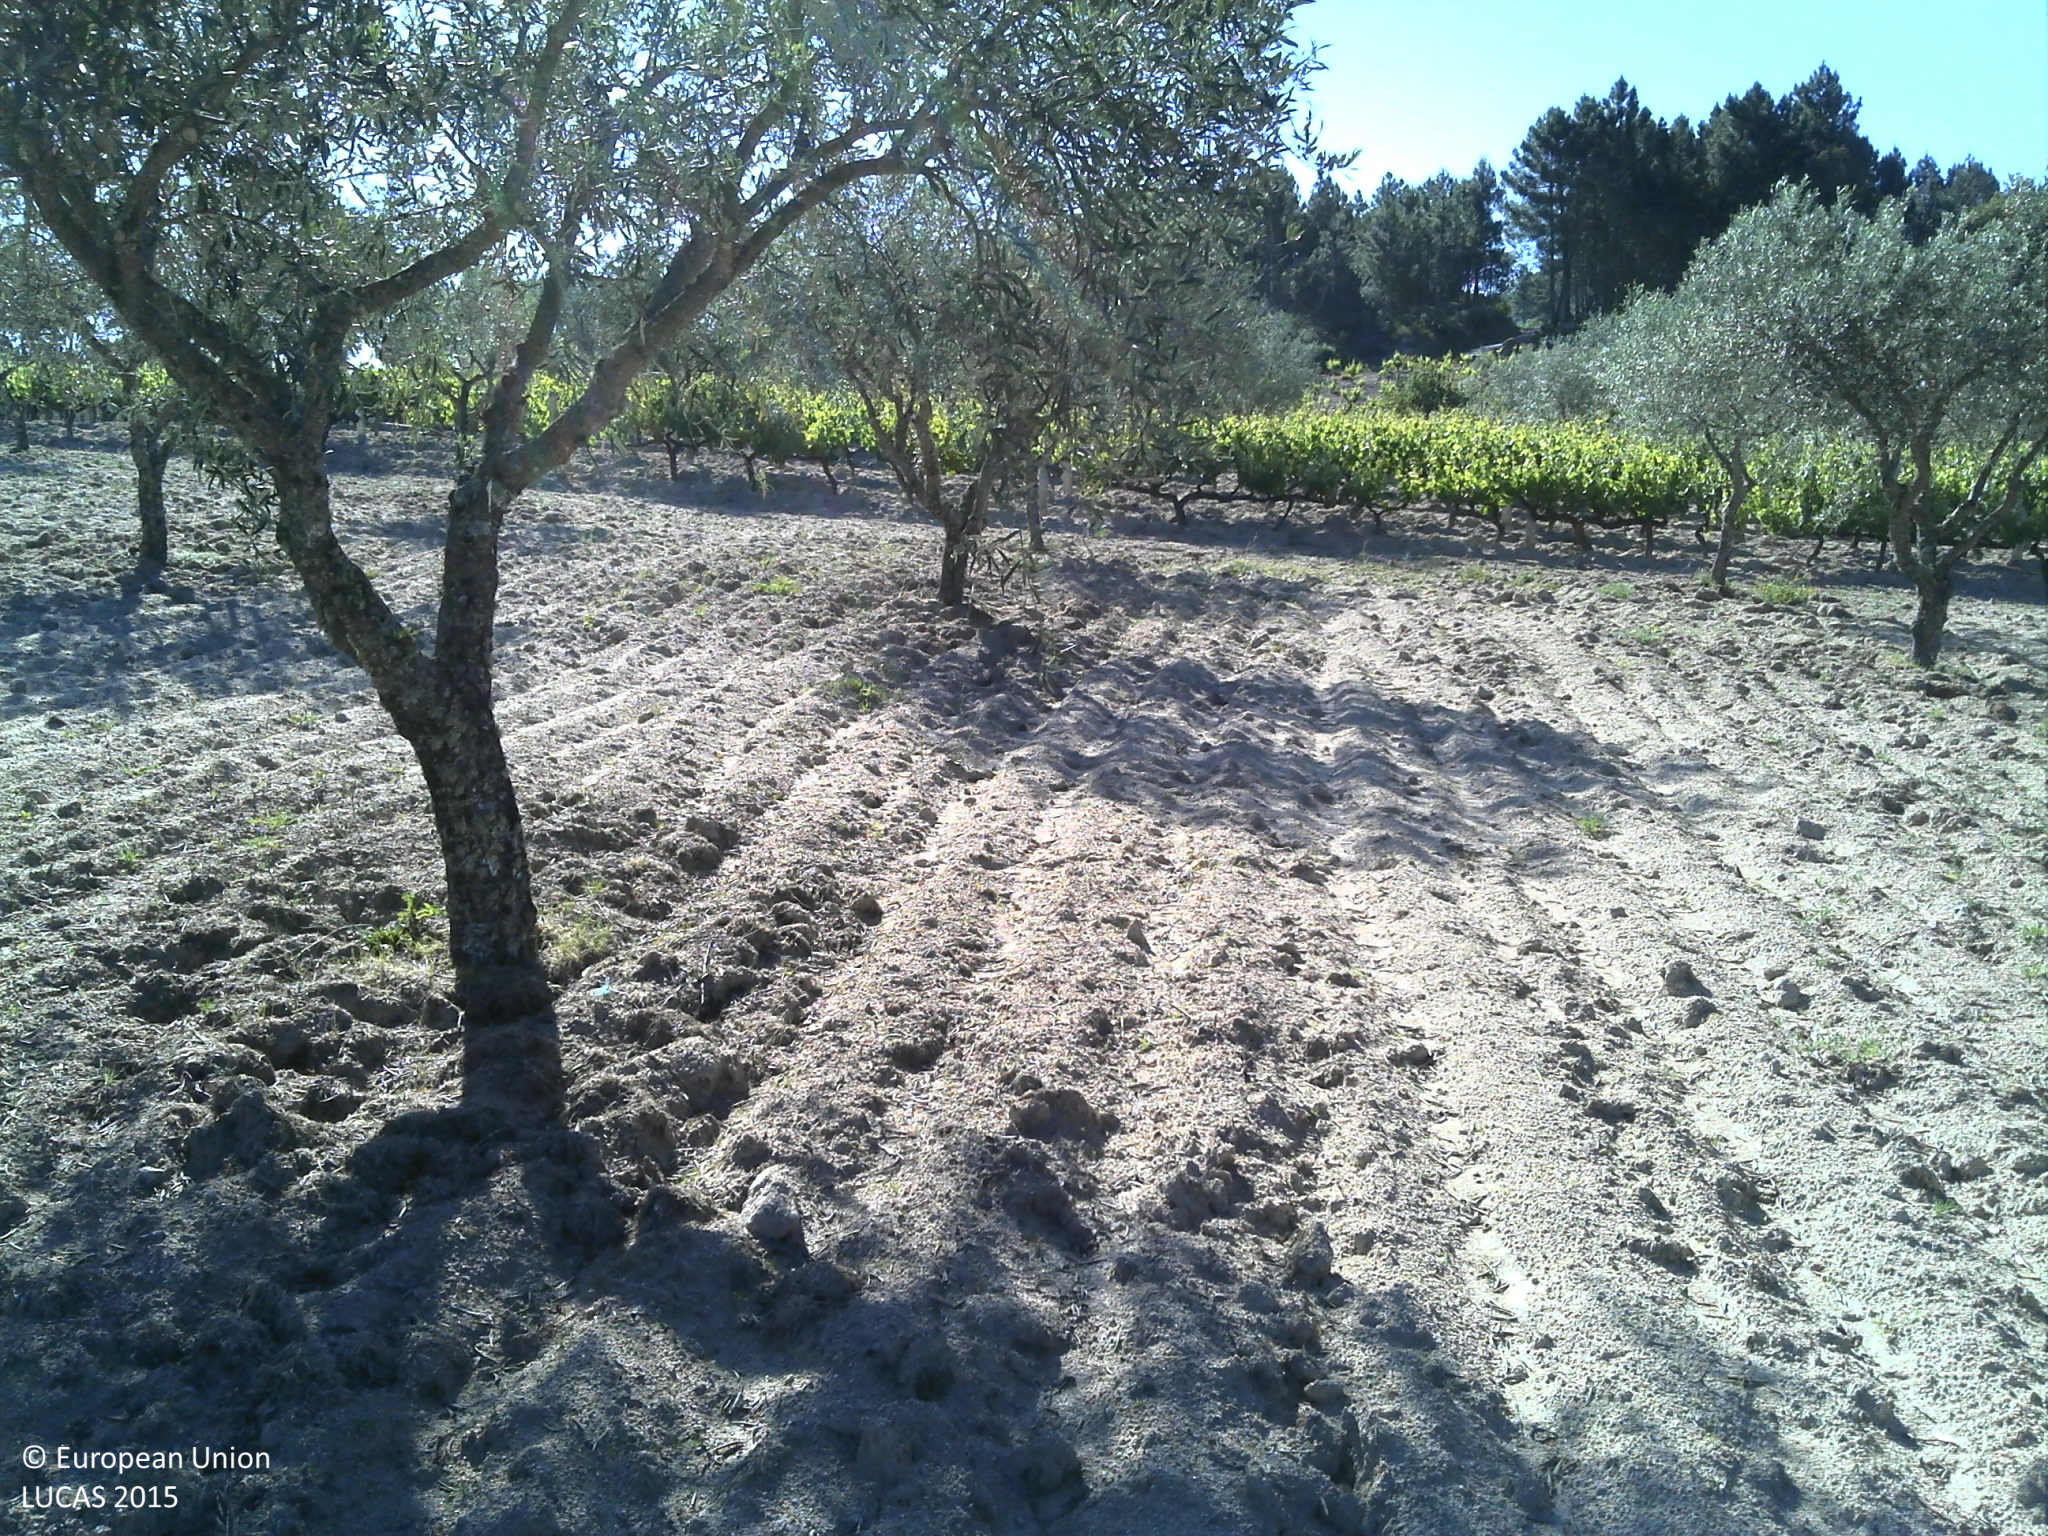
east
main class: Cropland
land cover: Olive groves
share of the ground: 25 - 50 %
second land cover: Other bare soil
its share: > 75 %
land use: Agriculture (excluding fallow land and kitchen gardens)
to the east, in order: Olive groves; Other bare soil; Vineyards; Paved roads, cycling and walking lanes; Dry stone walls; Vineyards; Shrubland with sparse tree cover; Pine dominated coniferous woodland; Shrubland with sparse tree cover; Pine dominated coniferous woodland
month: May
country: PT
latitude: 41.7257
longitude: -7.1807
